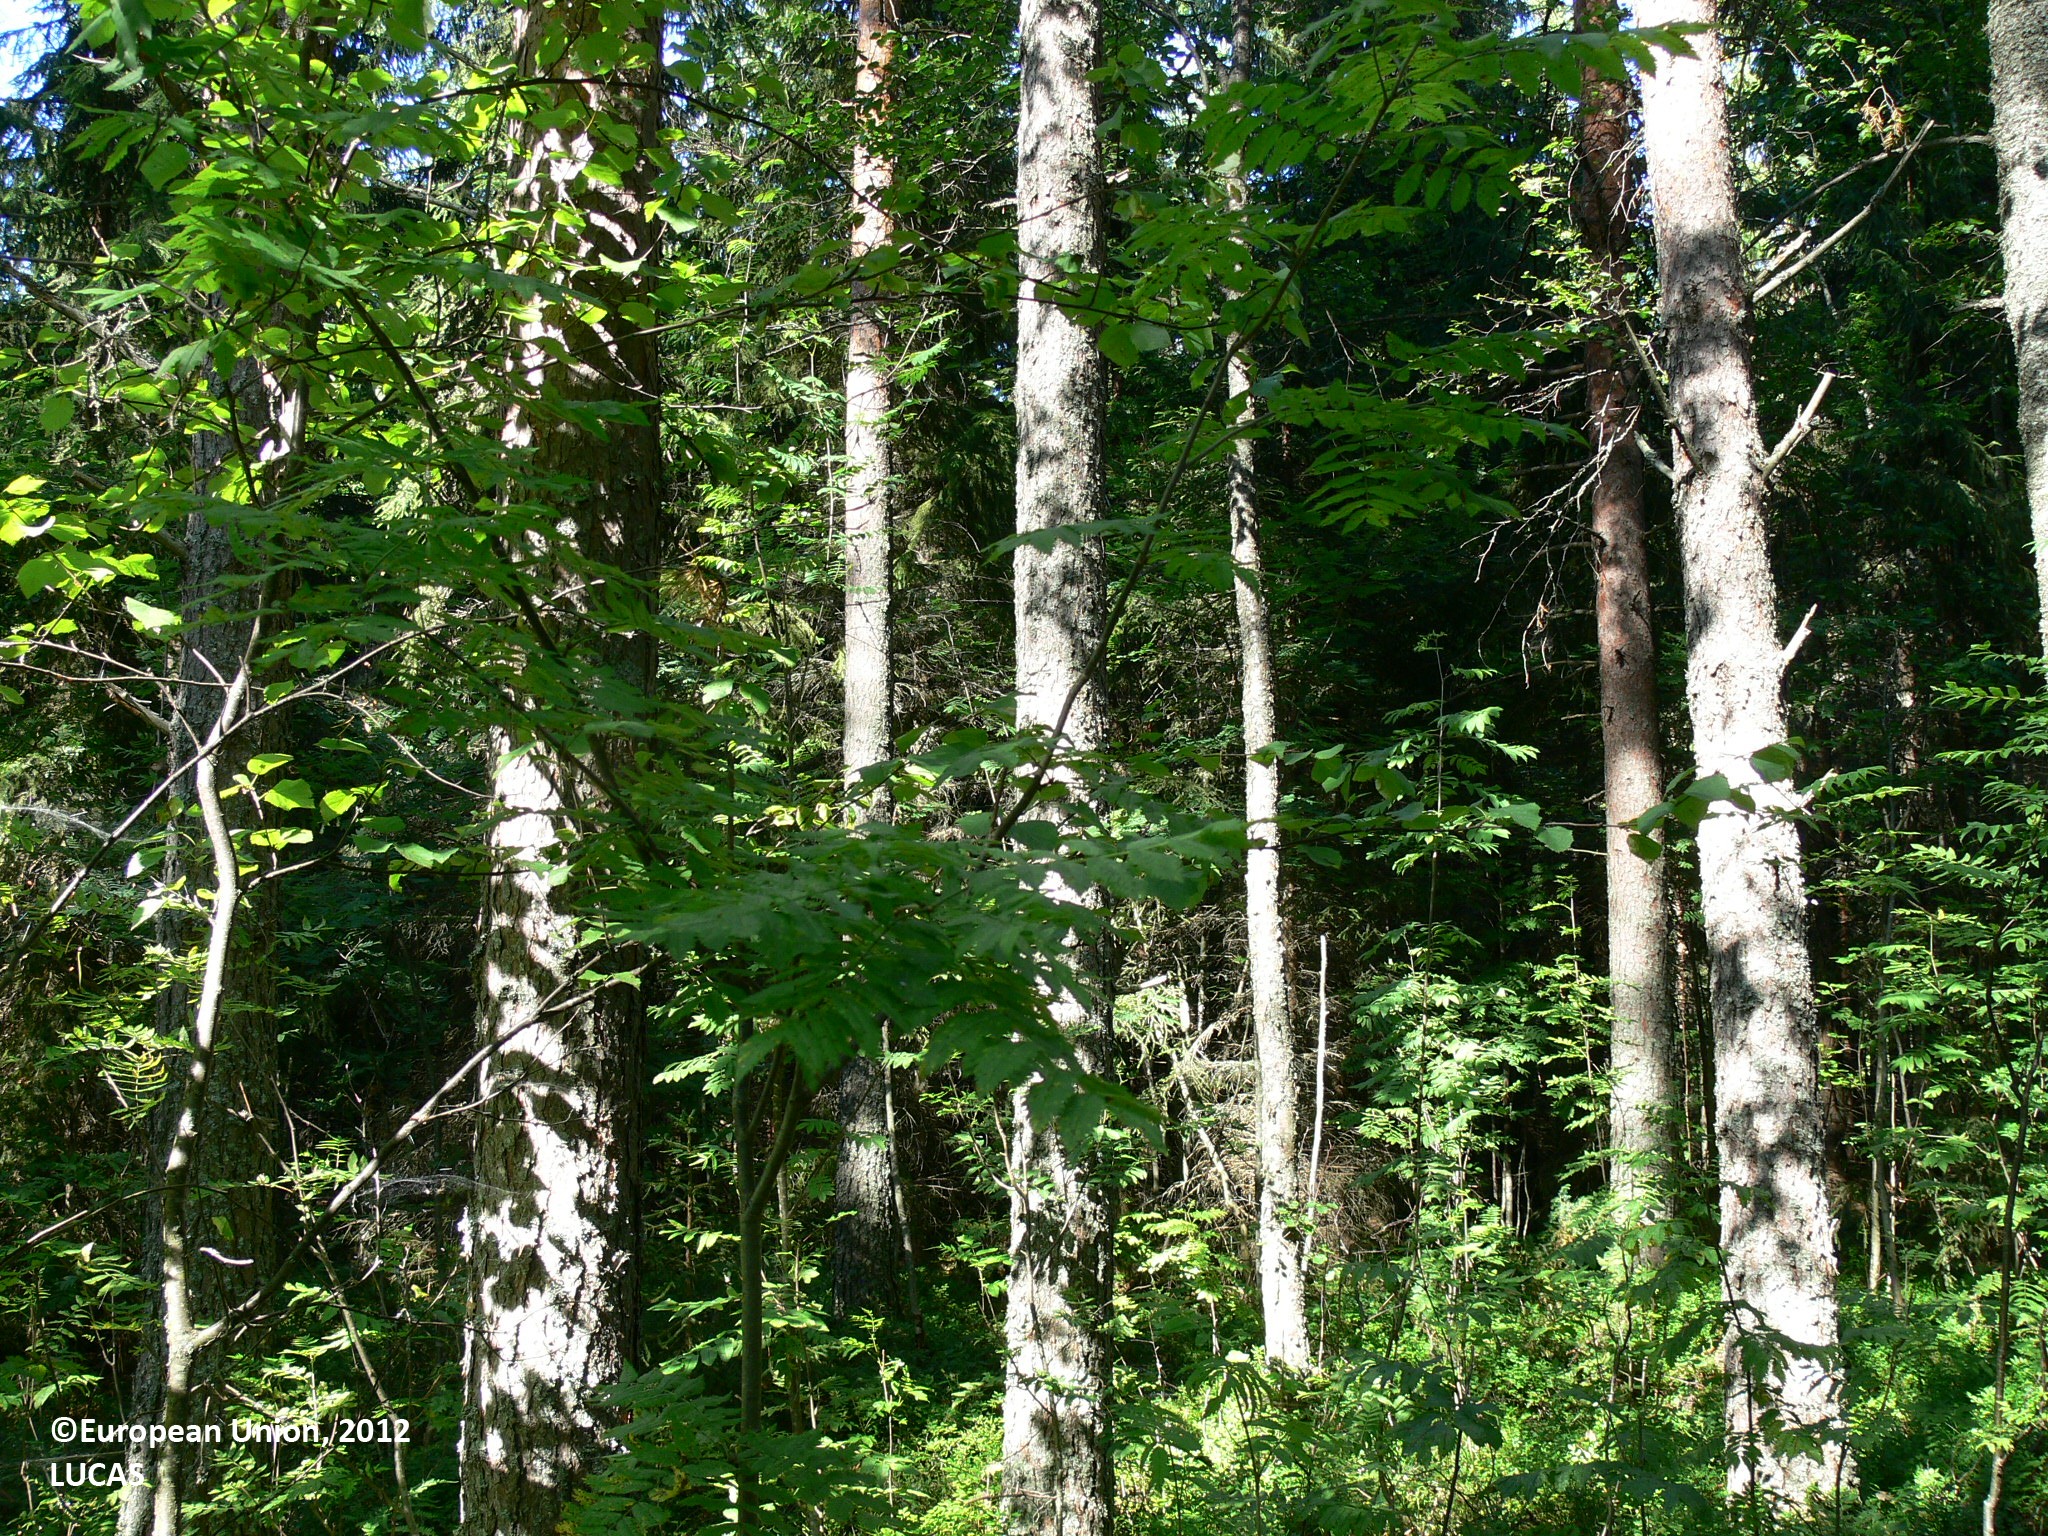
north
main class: Woodland
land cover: Pine dominated mixed woodland
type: boreal forest
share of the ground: > 75 %
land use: Forestry
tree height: > 5 m
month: July
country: FI
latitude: 63.3284
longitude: 29.4154
